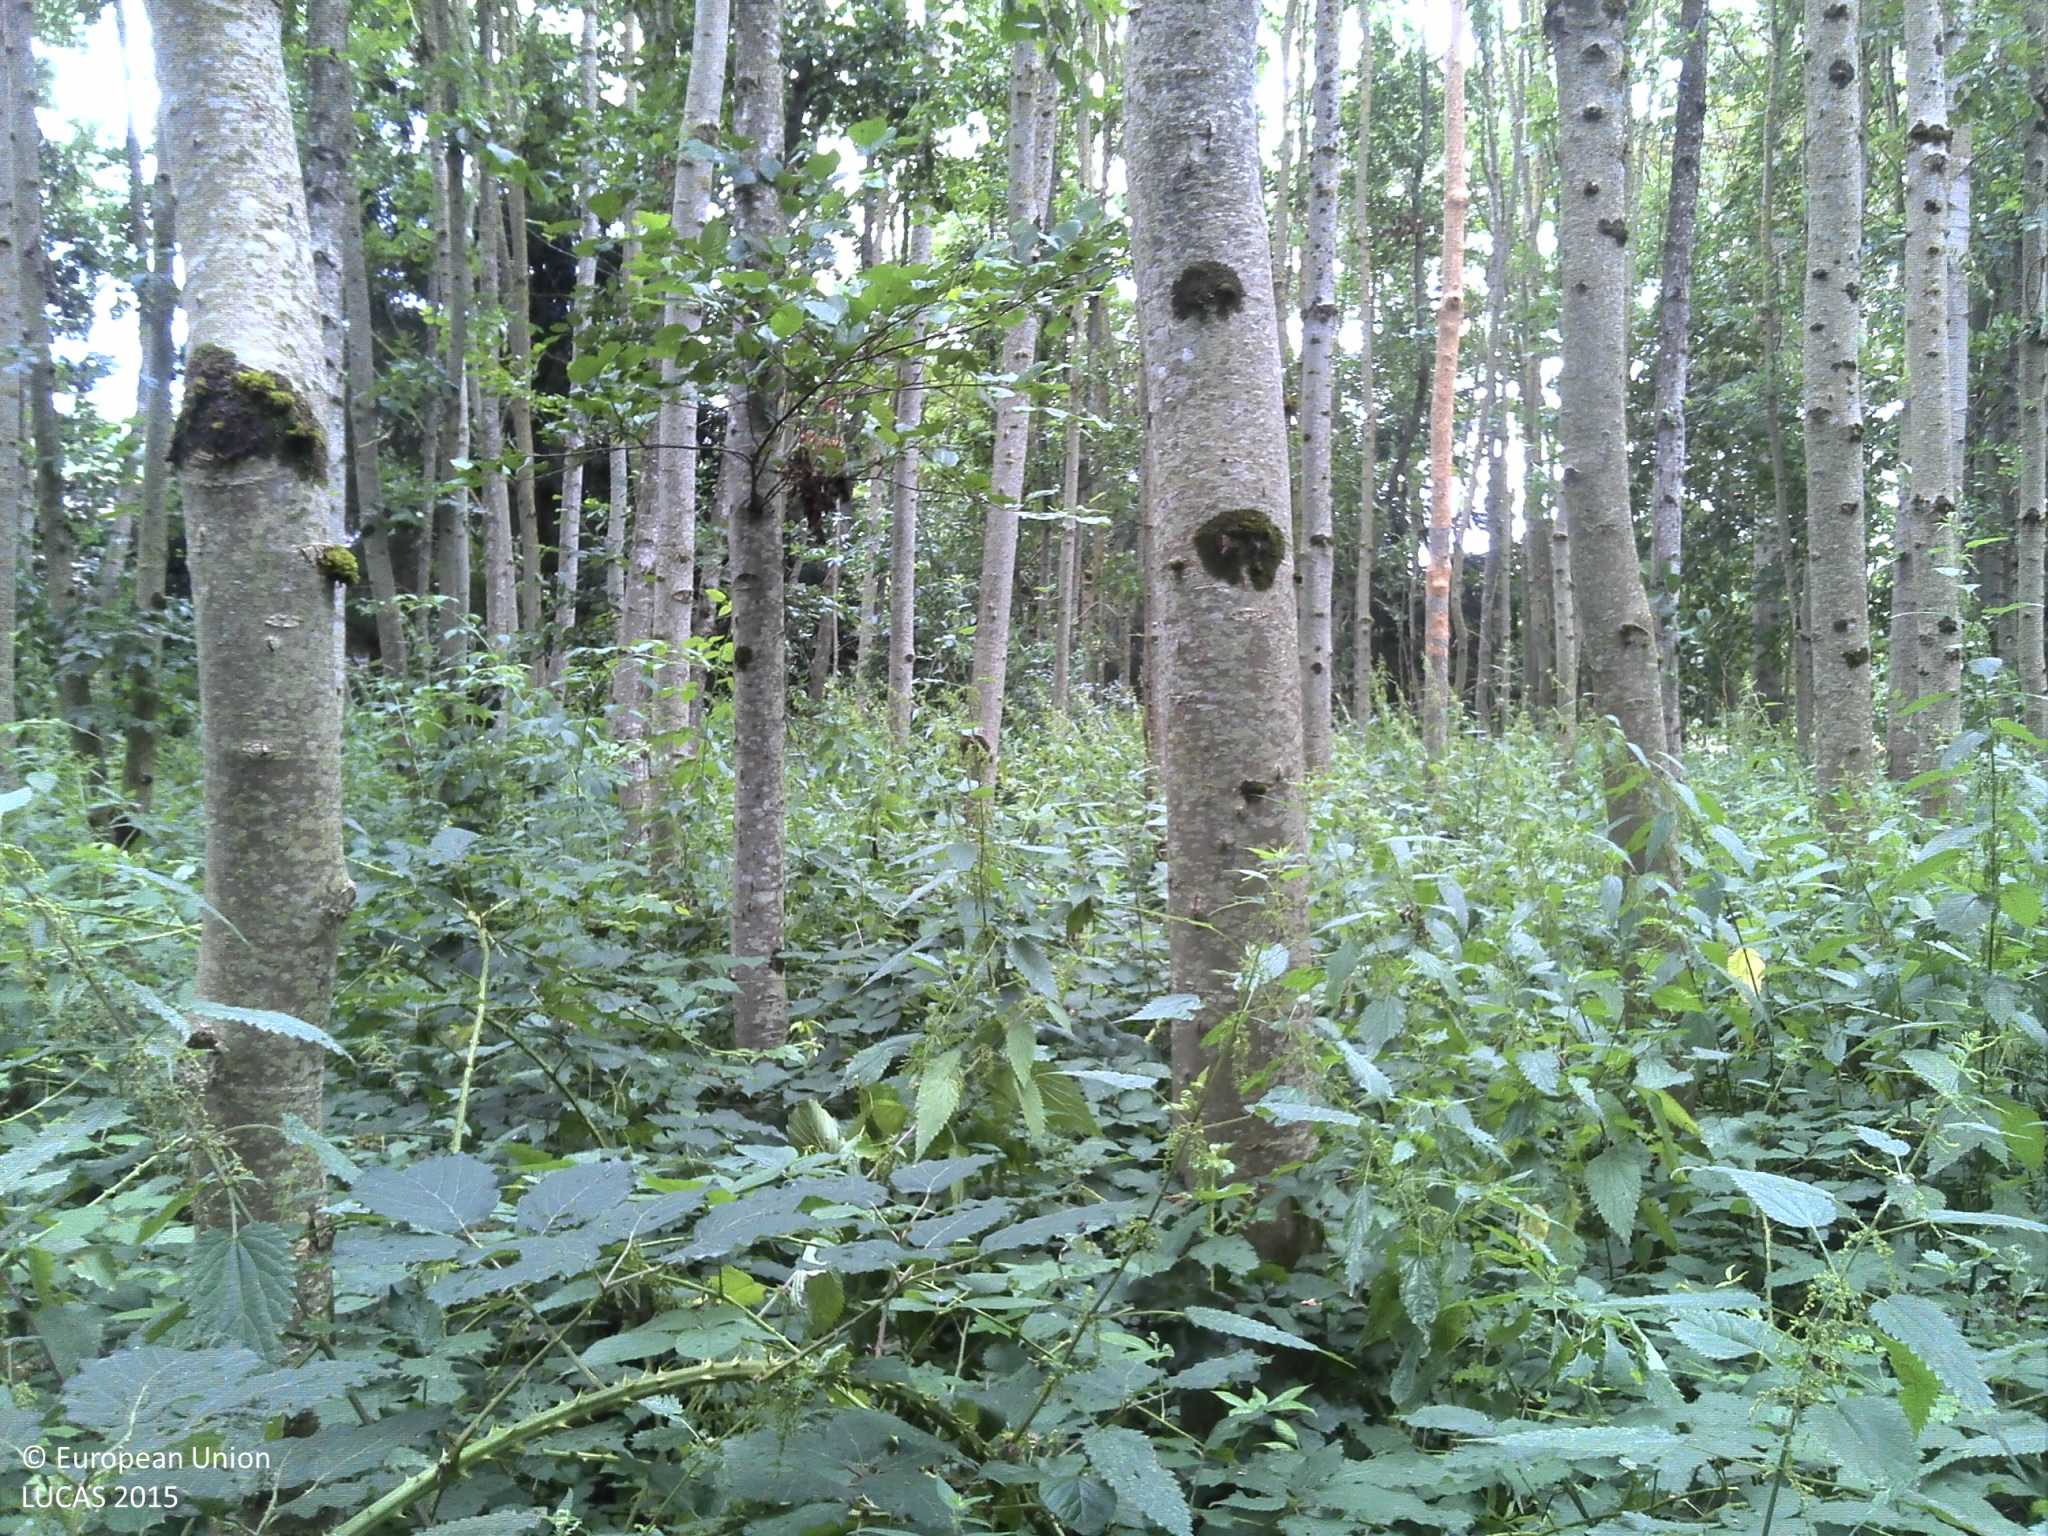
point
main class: Woodland
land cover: Broadleaved woodland
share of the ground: > 75 %
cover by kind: broadleaved forest trees 70 %, herbaceous plants 30 %
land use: Forestry
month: July
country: FR
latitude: 49.4463
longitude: 4.6589
